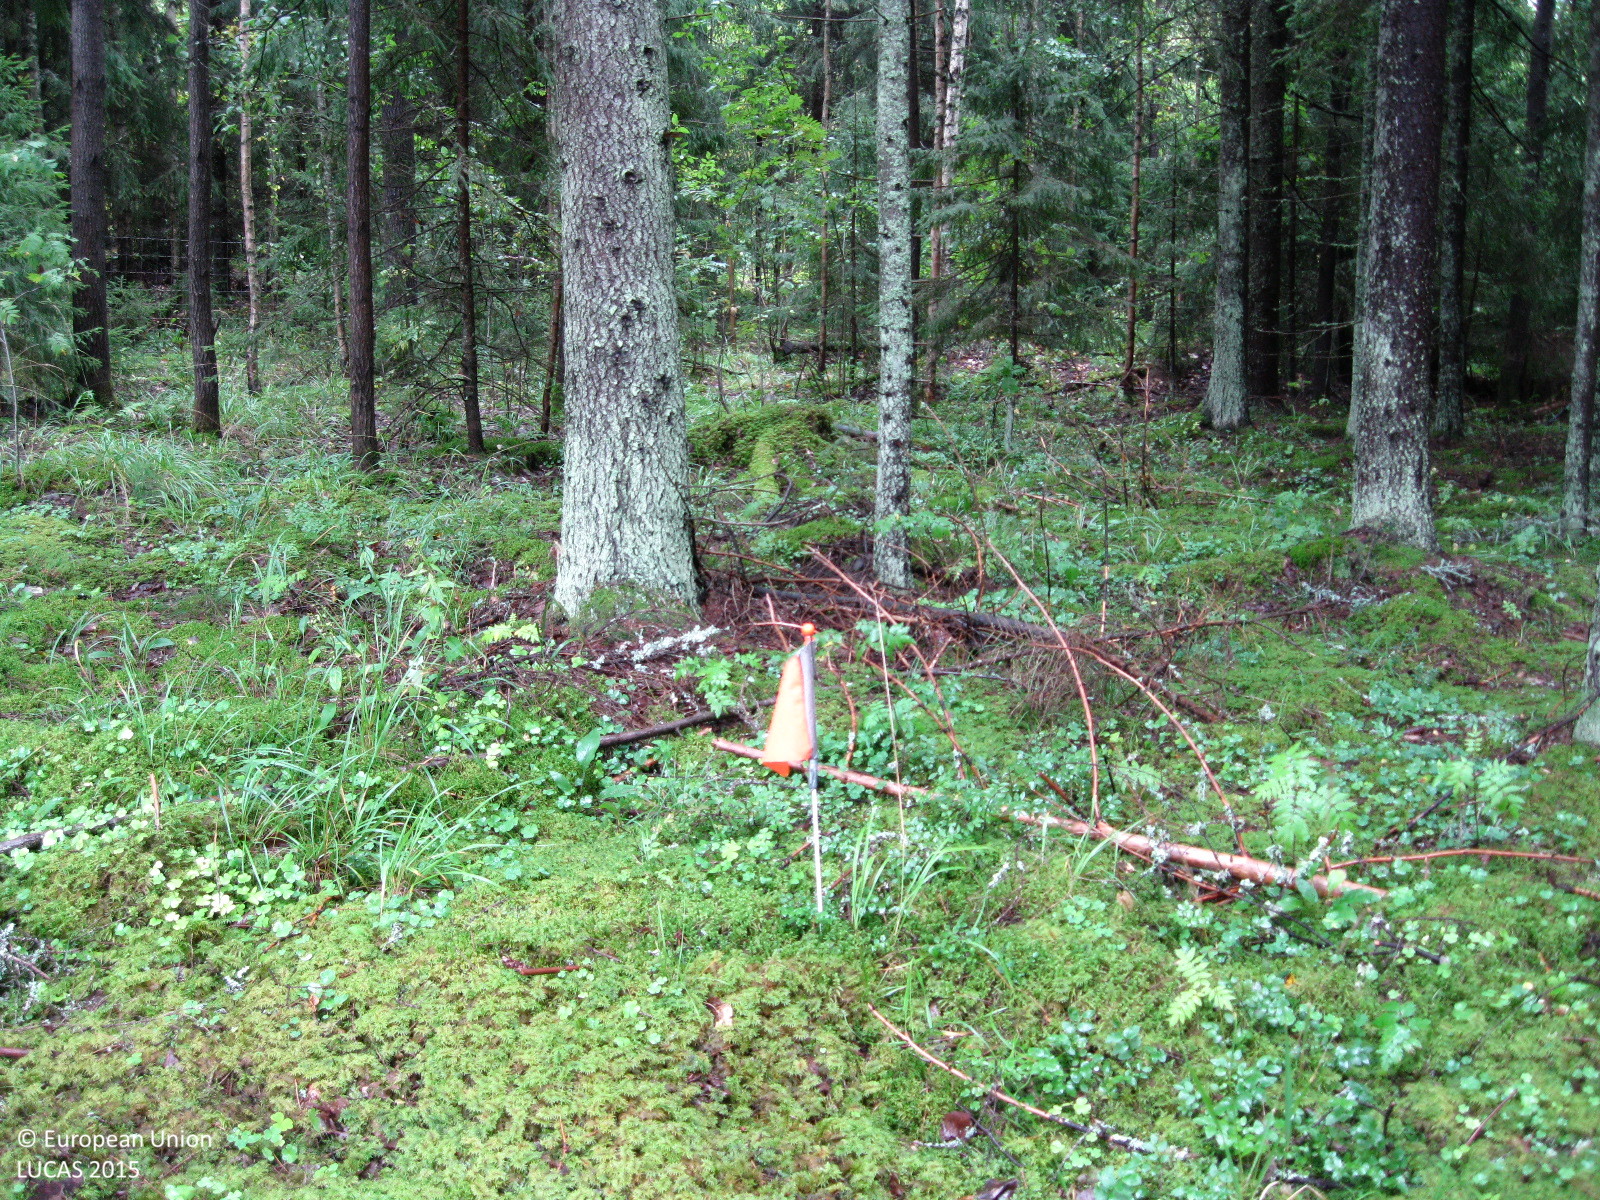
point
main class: Woodland
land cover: Spruce dominated coniferous woodland
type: boreal forest
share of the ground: > 75 %
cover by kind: coniferous forest trees 70 %, broadleaved forest trees 10 %, herbaceous plants 10 %, lichens and mosses 10 %
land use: Forestry
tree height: > 5 m
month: September
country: FI
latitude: 60.3875
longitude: 24.6054
